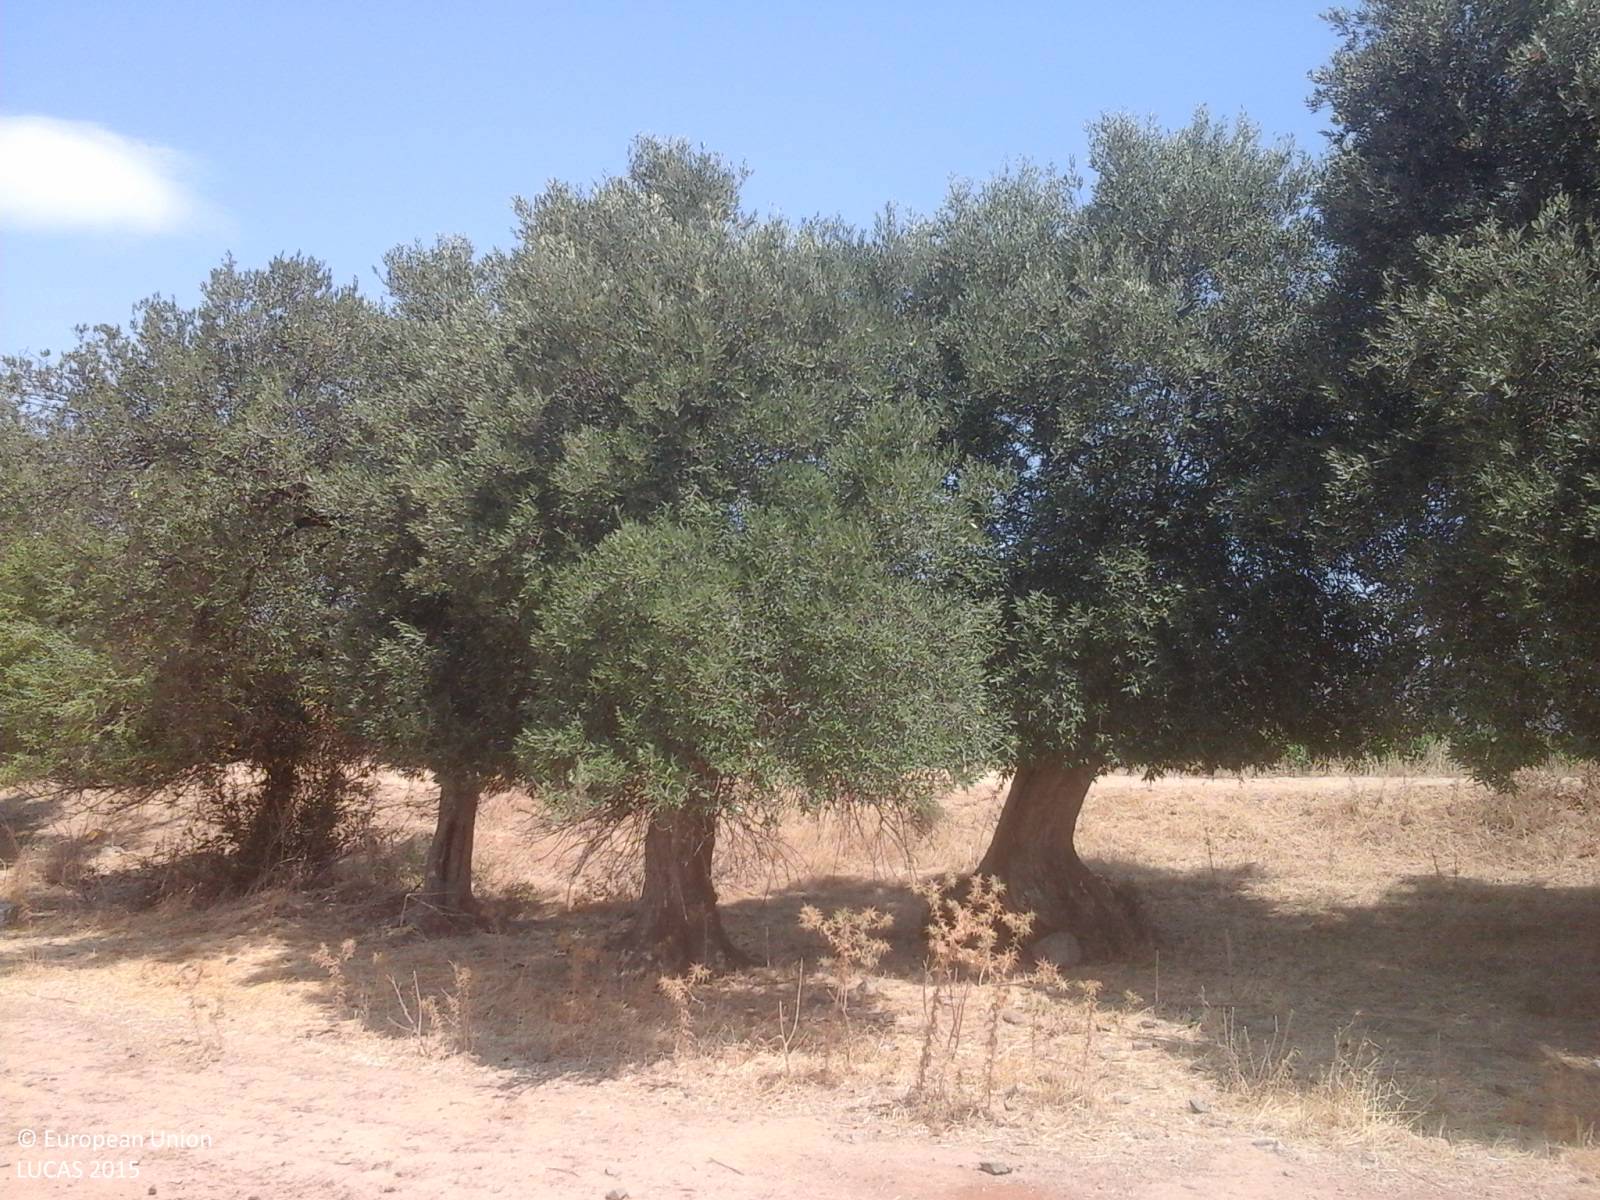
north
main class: Grassland
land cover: Grassland without tree/shrub cover
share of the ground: > 75 %
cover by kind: herbaceous plants 75 %, unconsolidated bare surface 20 %, consolidated bare surface 5 %
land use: Agriculture (excluding fallow land and kitchen gardens)
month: July
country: IT
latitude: 39.1172
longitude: 8.6783
